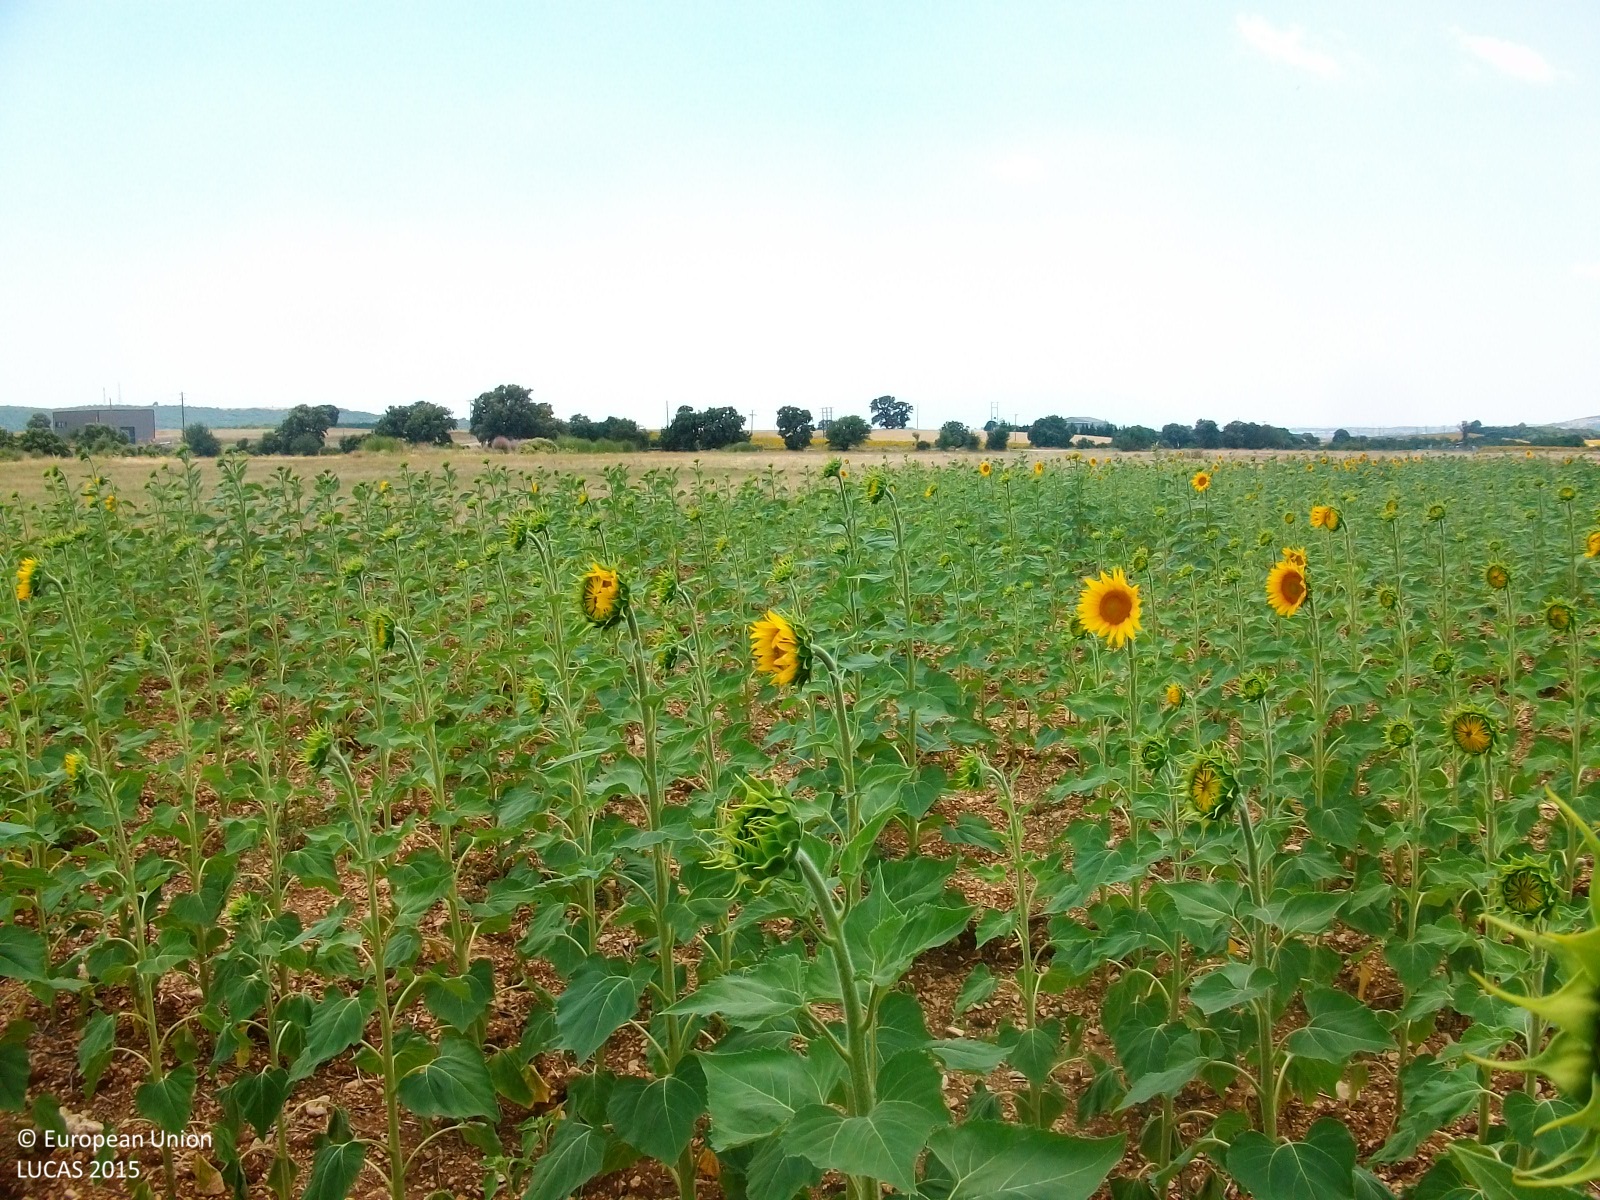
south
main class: Cropland
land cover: Sunflower
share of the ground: > 75 %
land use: Agriculture (excluding fallow land and kitchen gardens)
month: July
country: GR
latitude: 40.9236
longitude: 25.9349
